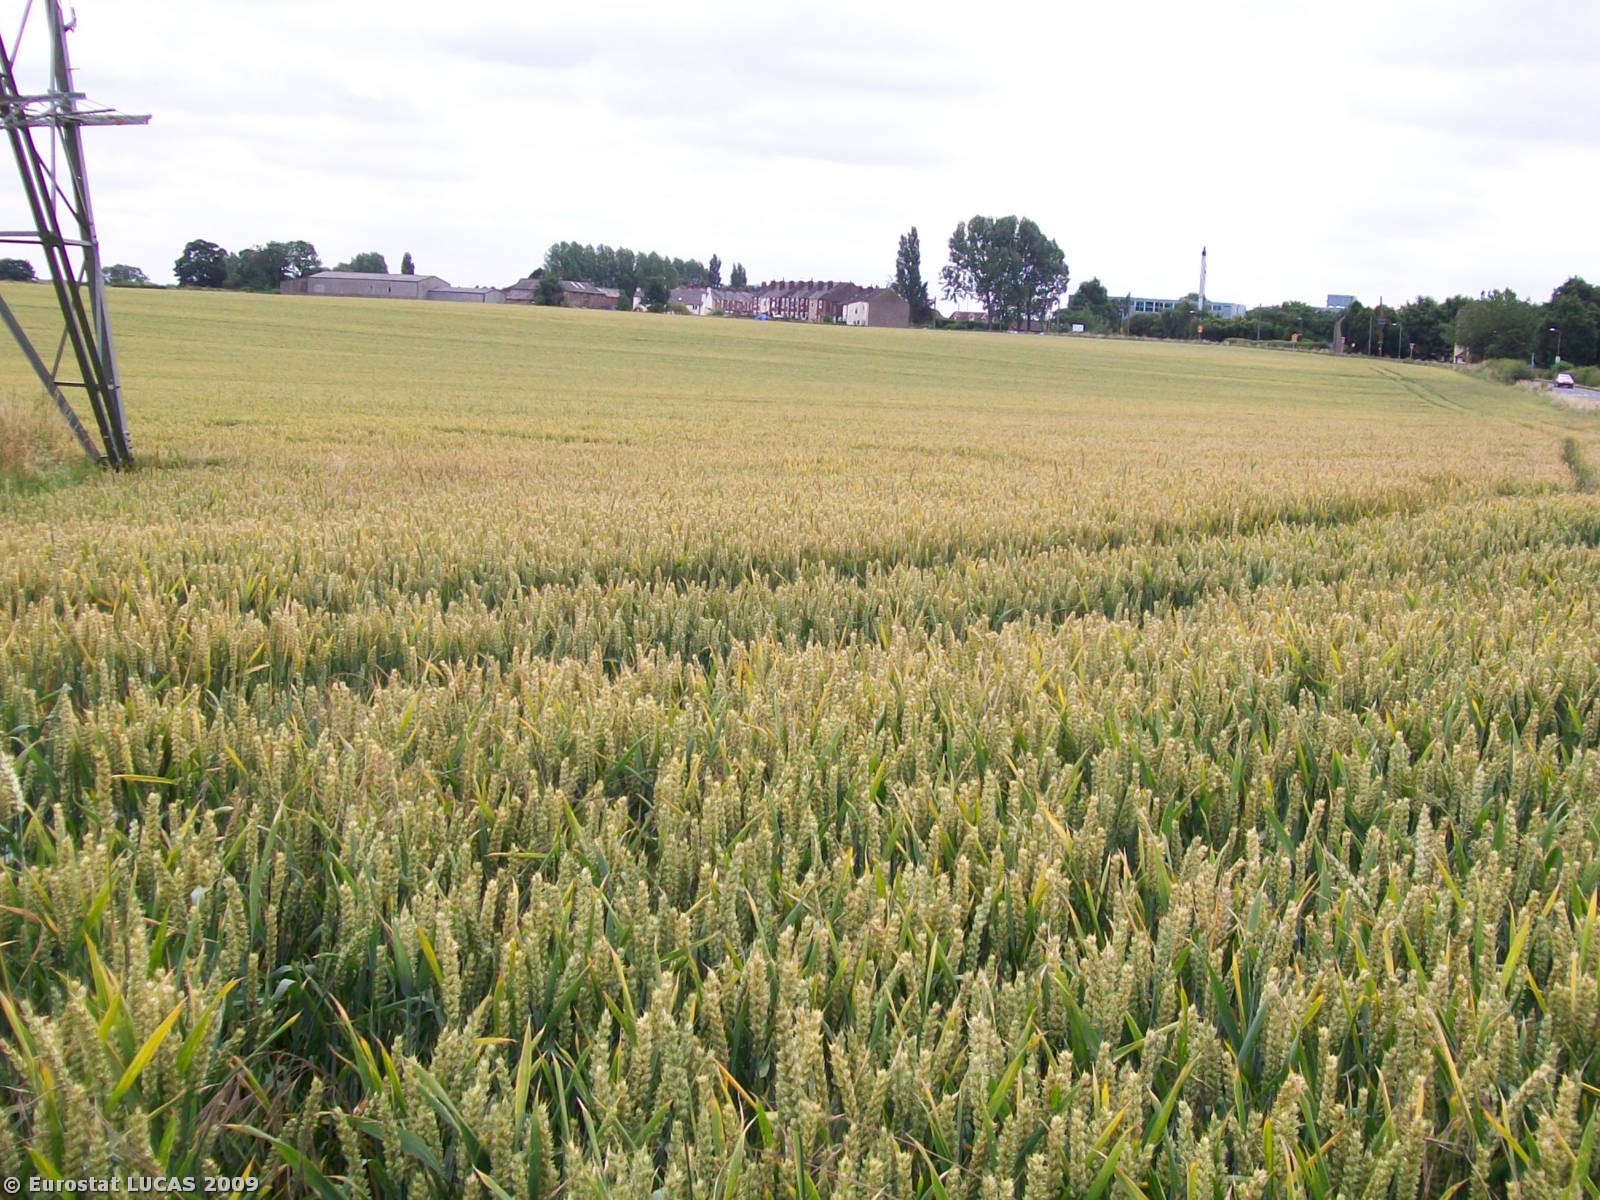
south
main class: Cropland
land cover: Common wheat
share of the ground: > 75 %
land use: Agriculture (excluding fallow land and kitchen gardens)
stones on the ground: < 10 %
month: July
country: GB
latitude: 53.7007
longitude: -1.3628
